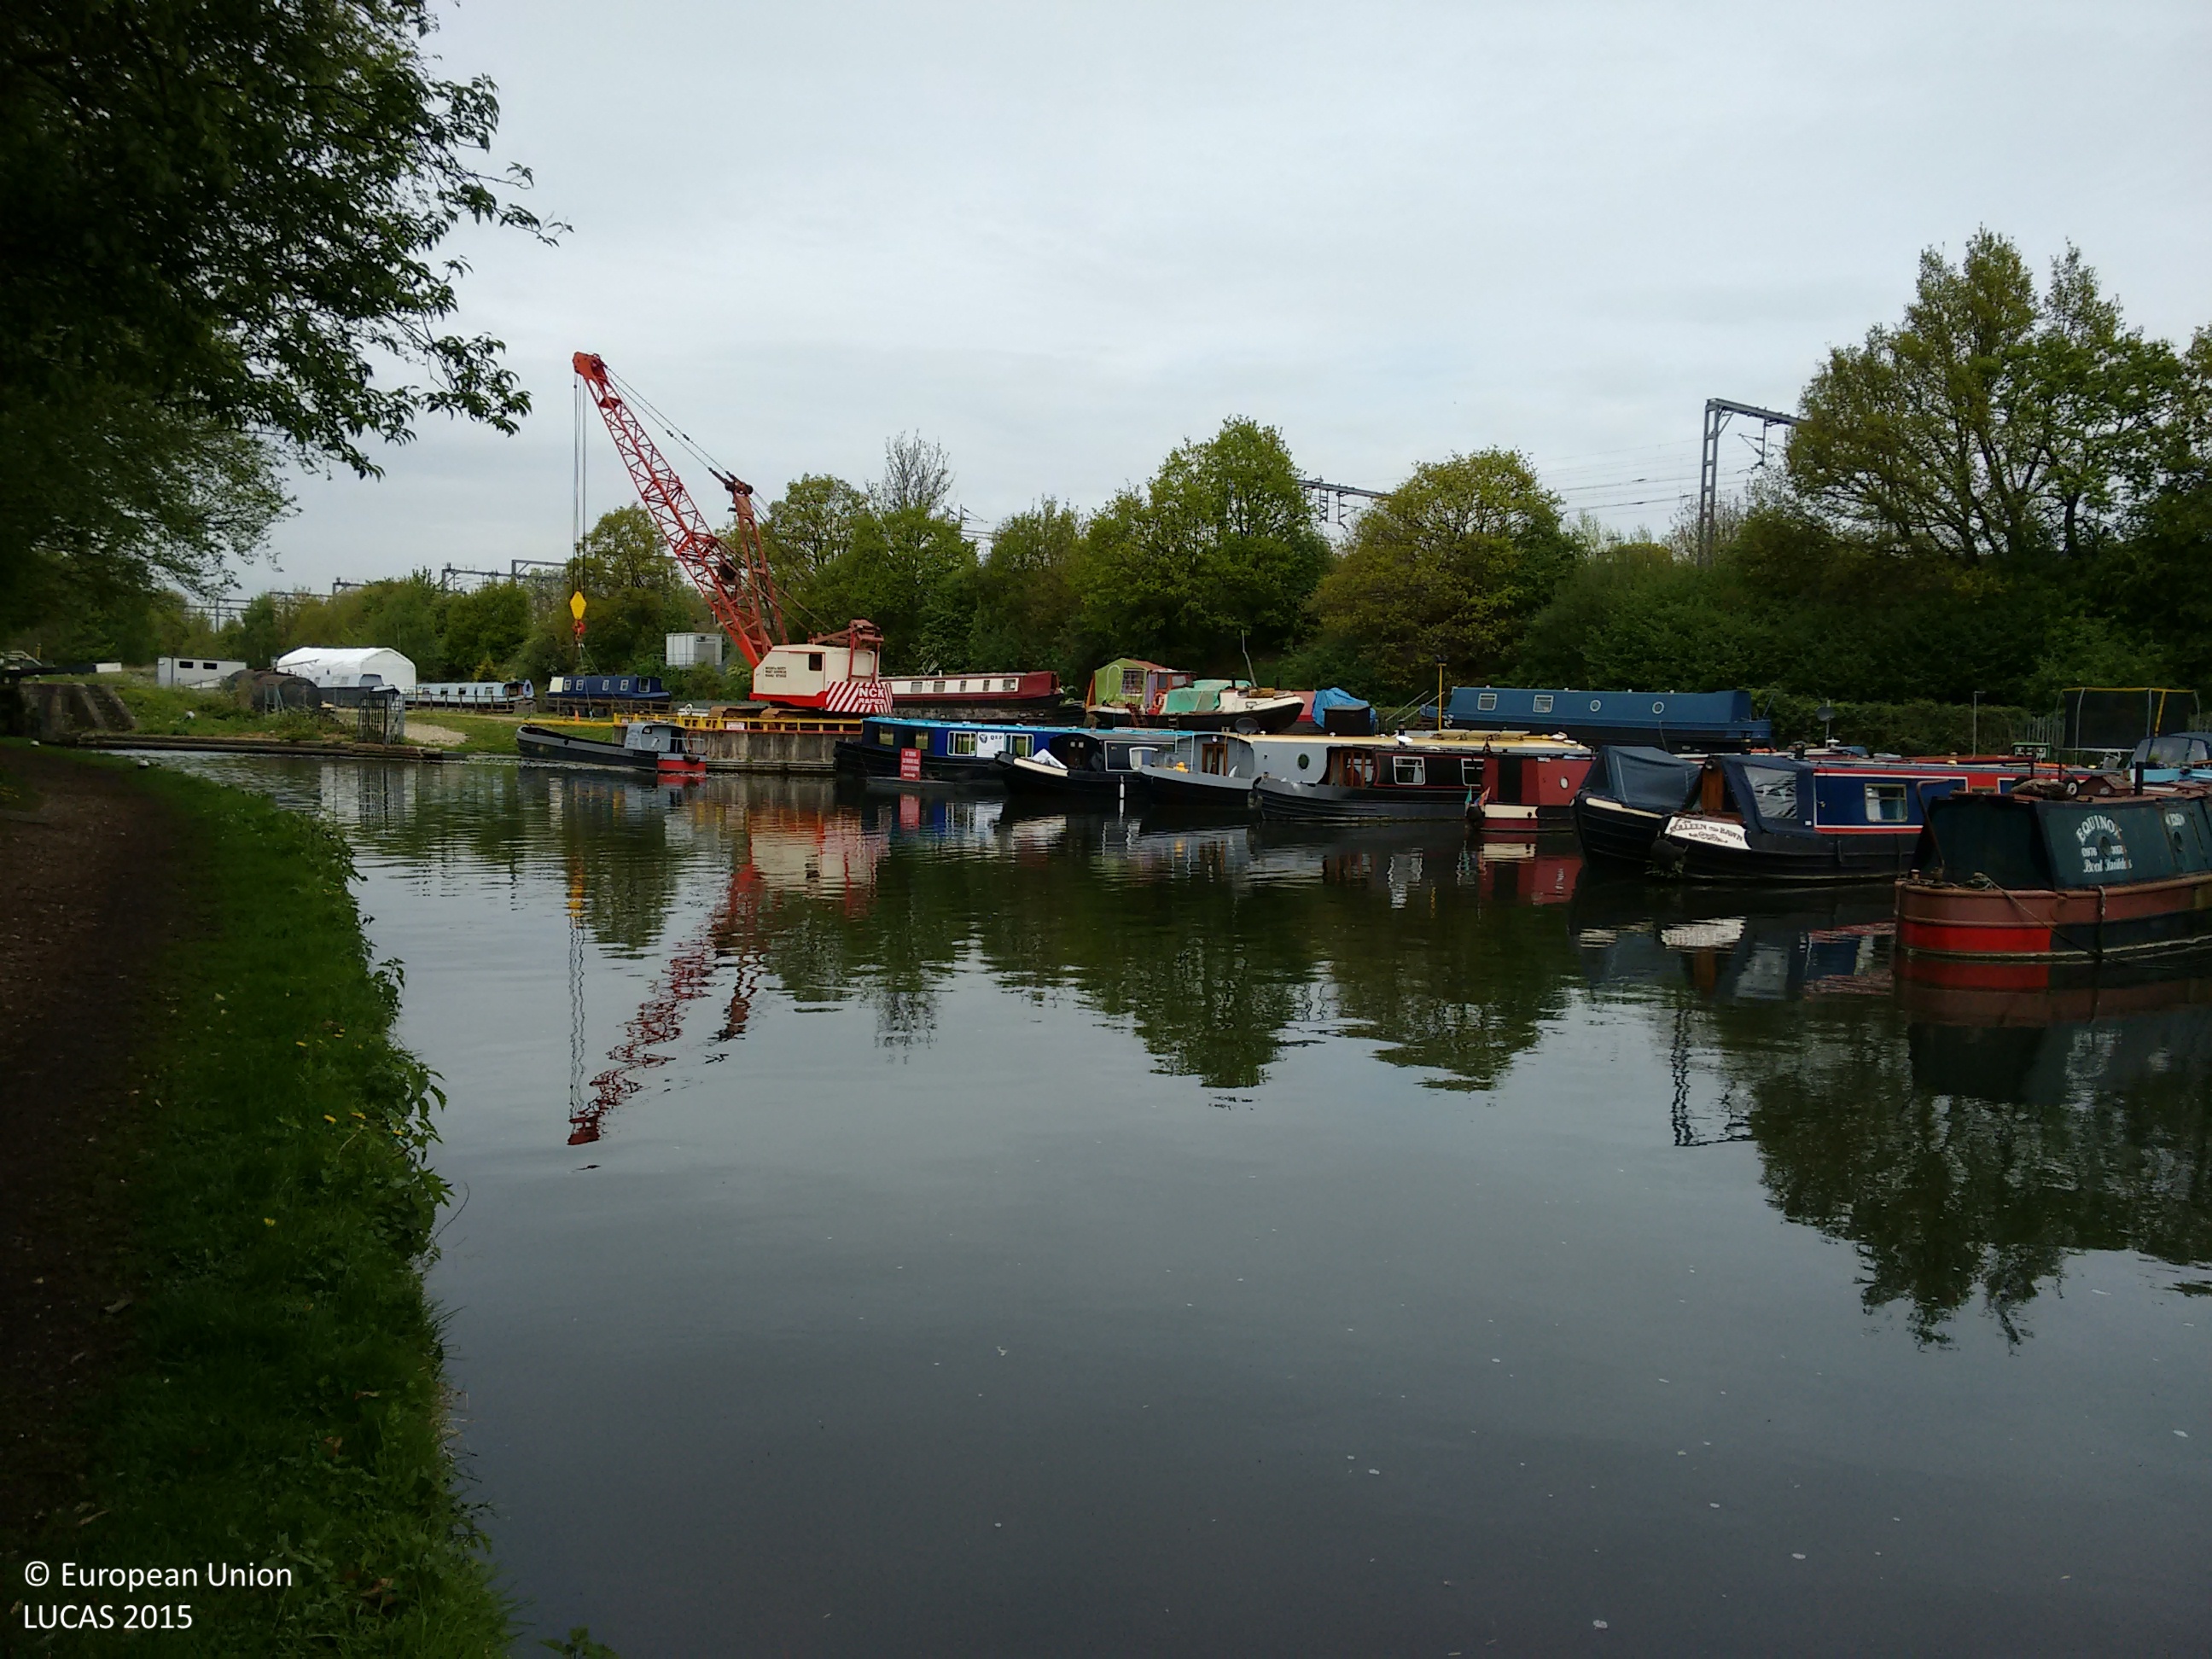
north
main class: Grassland
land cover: Grassland without tree/shrub cover
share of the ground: > 75 %
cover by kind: herbaceous plants 100 %
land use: Amenities, museums, leisure
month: May
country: GB
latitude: 51.7463
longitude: -0.5103
